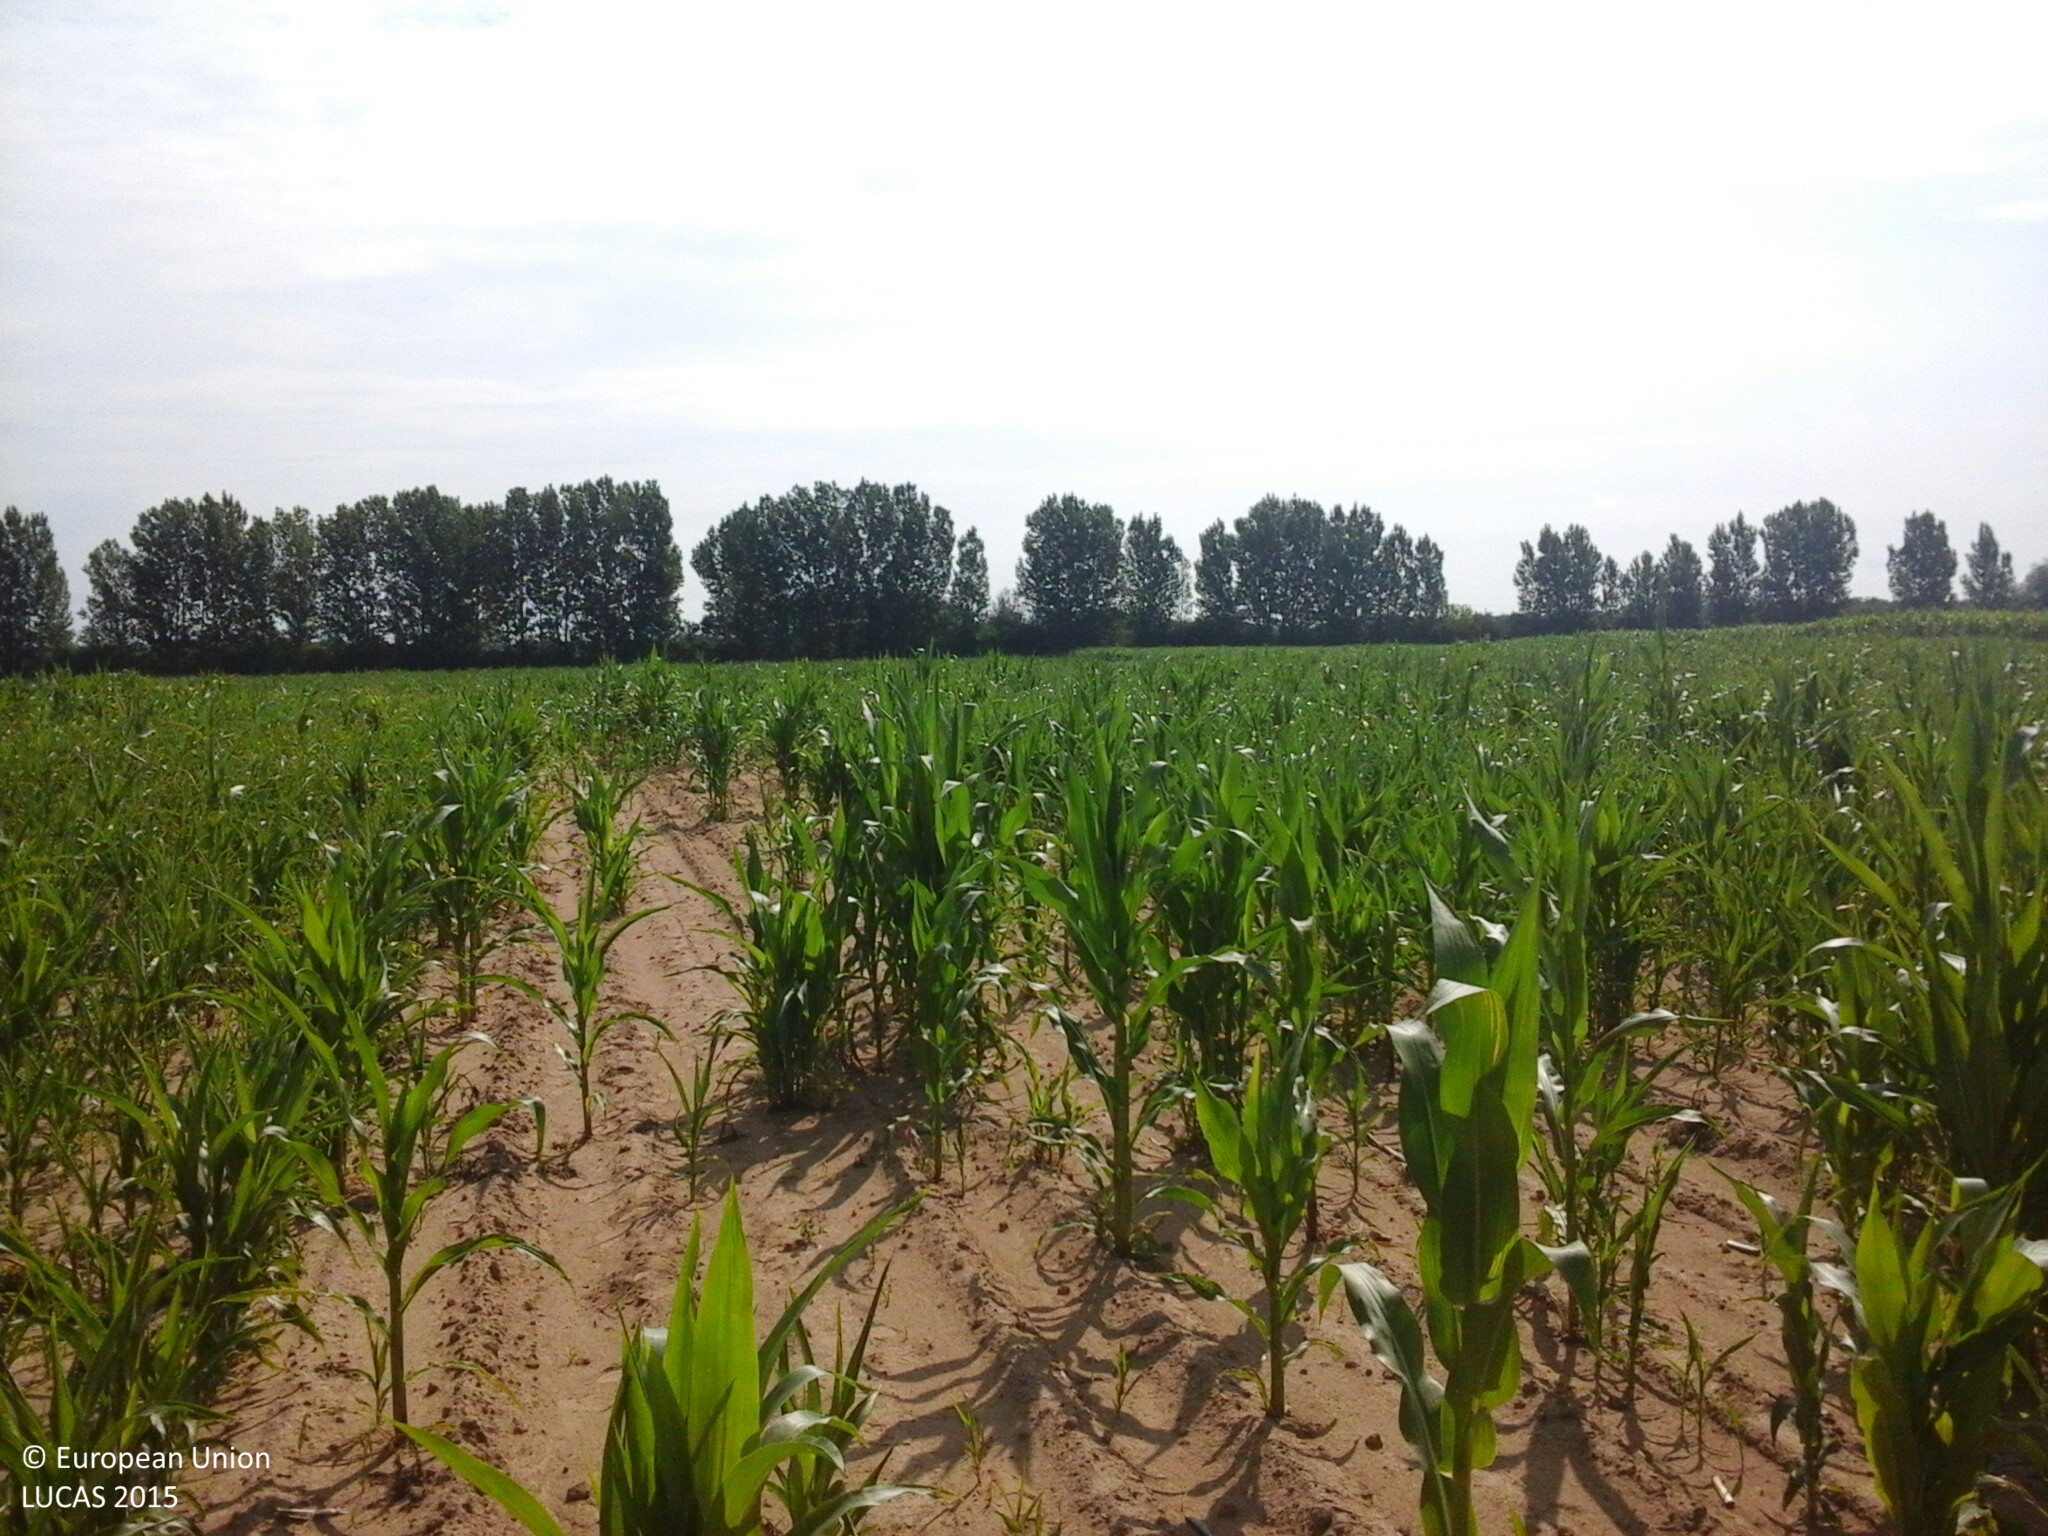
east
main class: Cropland
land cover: Maize
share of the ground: 50 - 75 %
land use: Agriculture (excluding fallow land and kitchen gardens)
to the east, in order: Maize
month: July
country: HU
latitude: 48.3983
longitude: 22.1992
